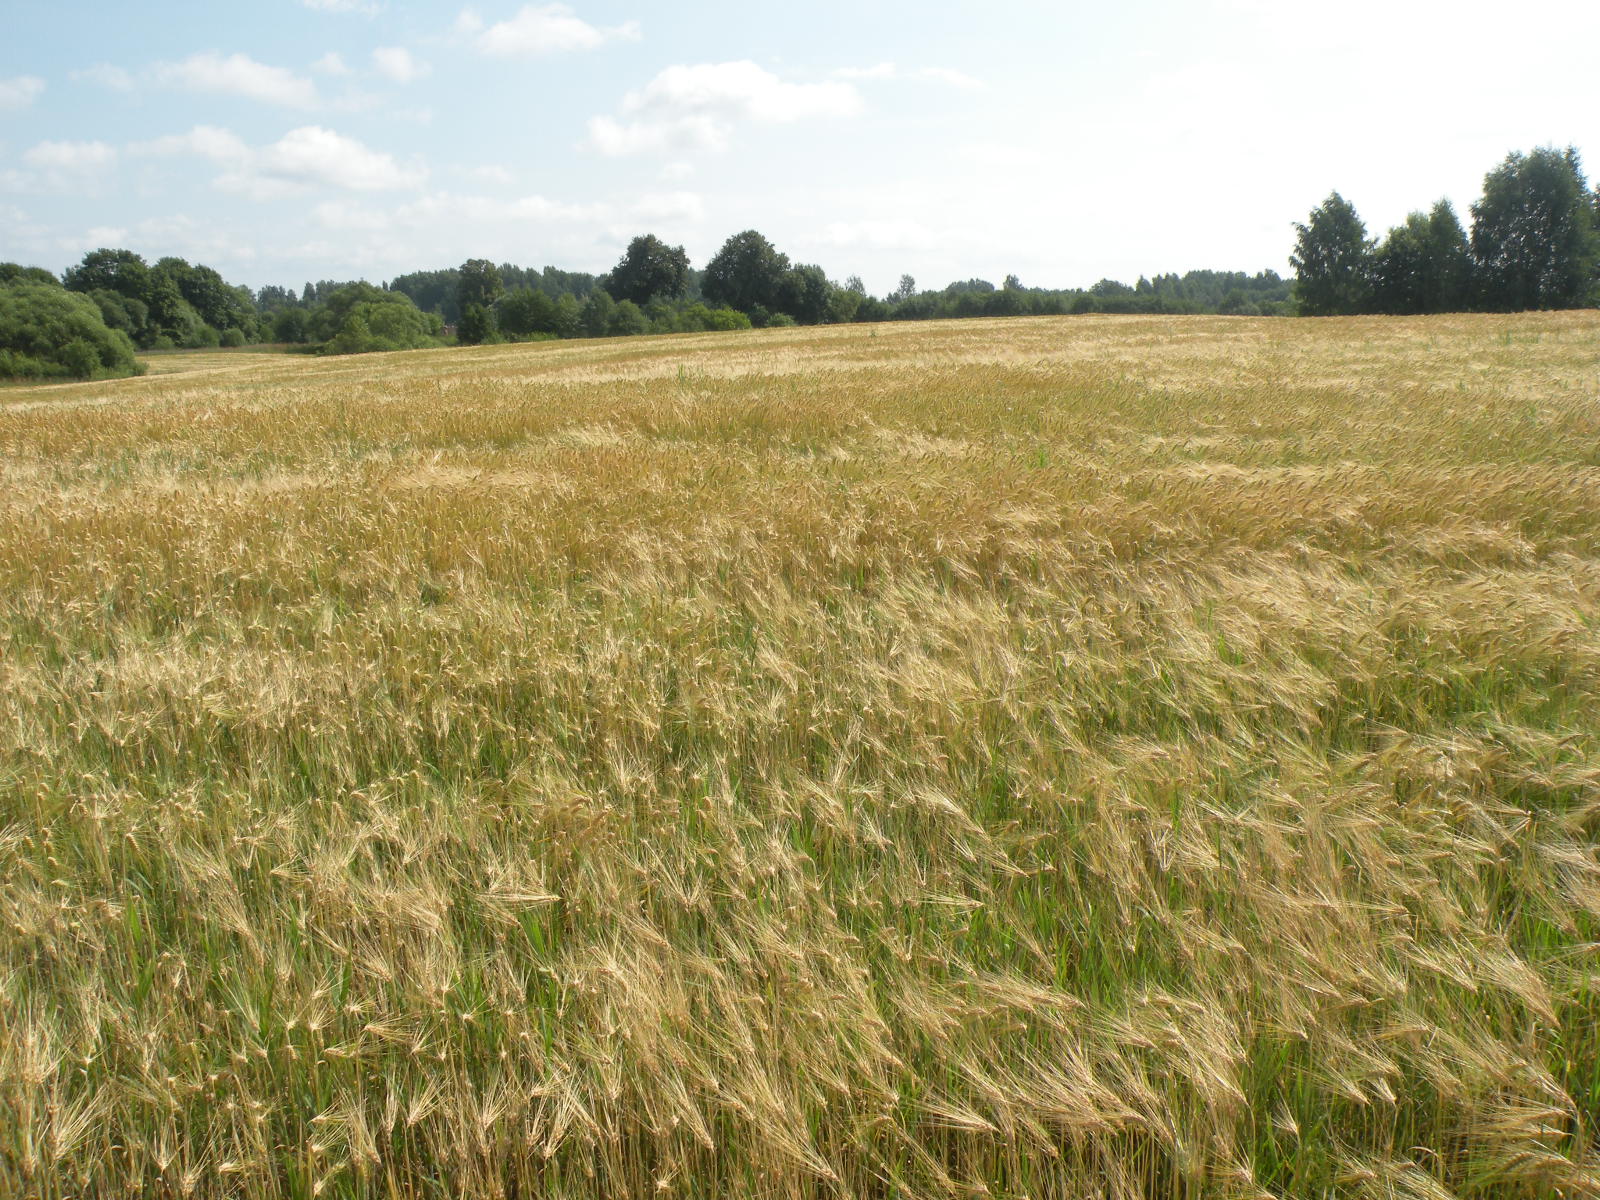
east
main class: Cropland
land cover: Barley
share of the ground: > 75 %
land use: Agriculture (excluding fallow land and kitchen gardens)
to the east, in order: Barley; Broadleaved woodland; Ditches and canals; Broadleaved woodland; Spontaneously vegetated surfaces
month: July
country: LV
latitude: 55.8518
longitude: 26.7220
